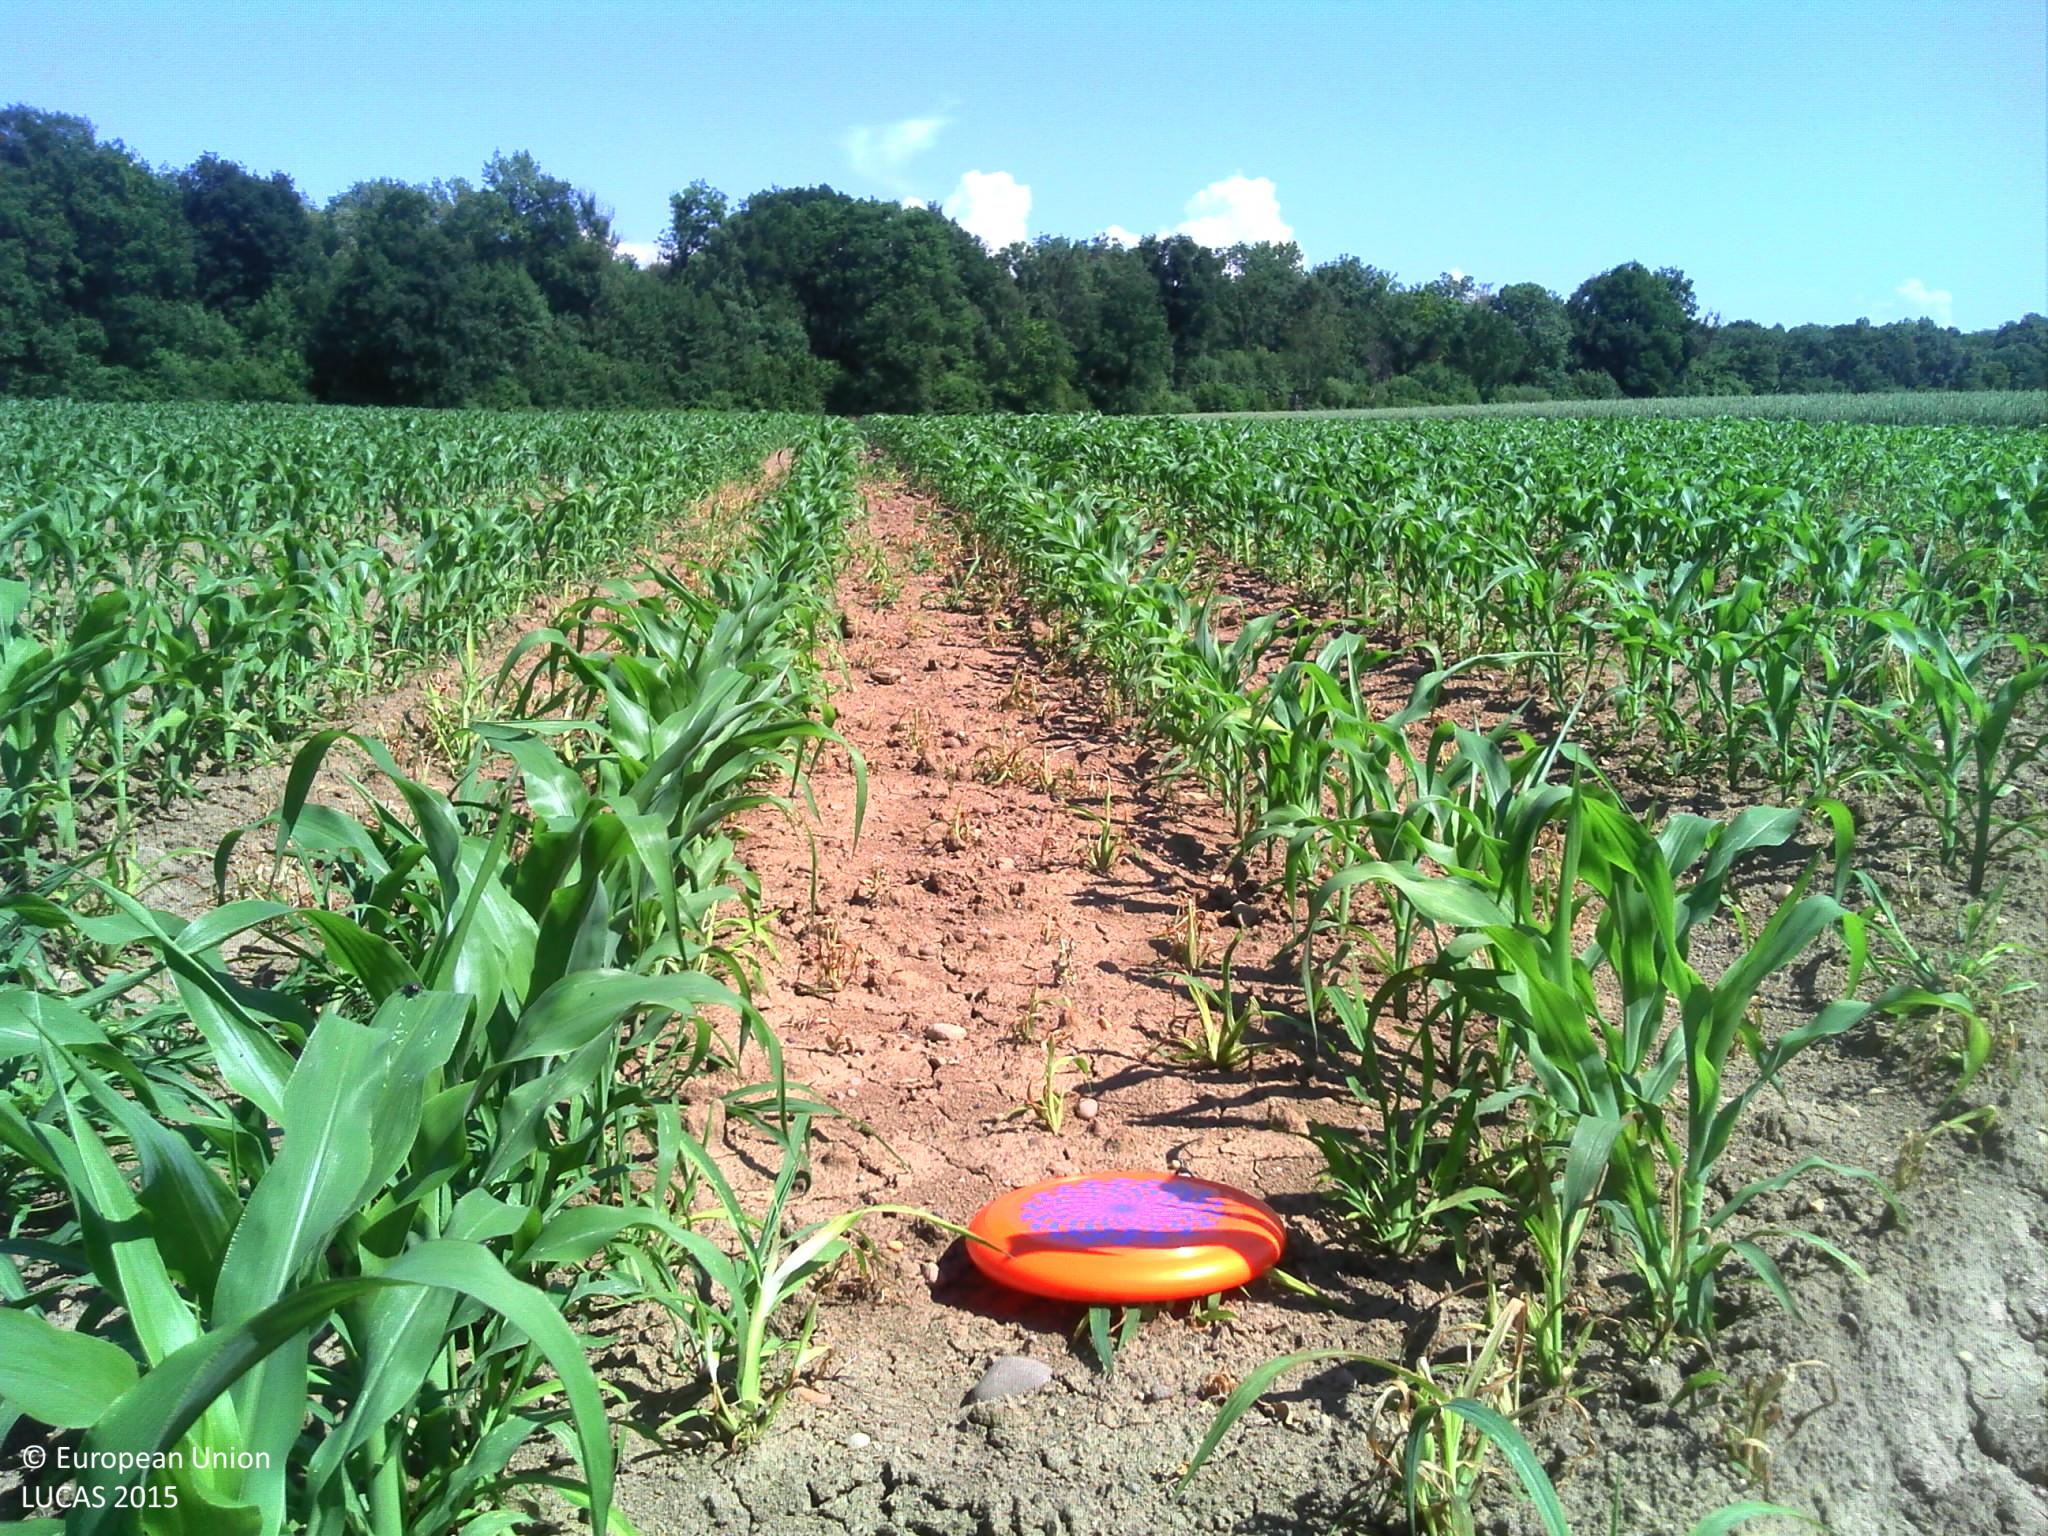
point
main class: Cropland
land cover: Maize
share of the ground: 10 - 25 %
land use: Agriculture (excluding fallow land and kitchen gardens)
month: June
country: FR
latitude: 48.4496
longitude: 7.6078
